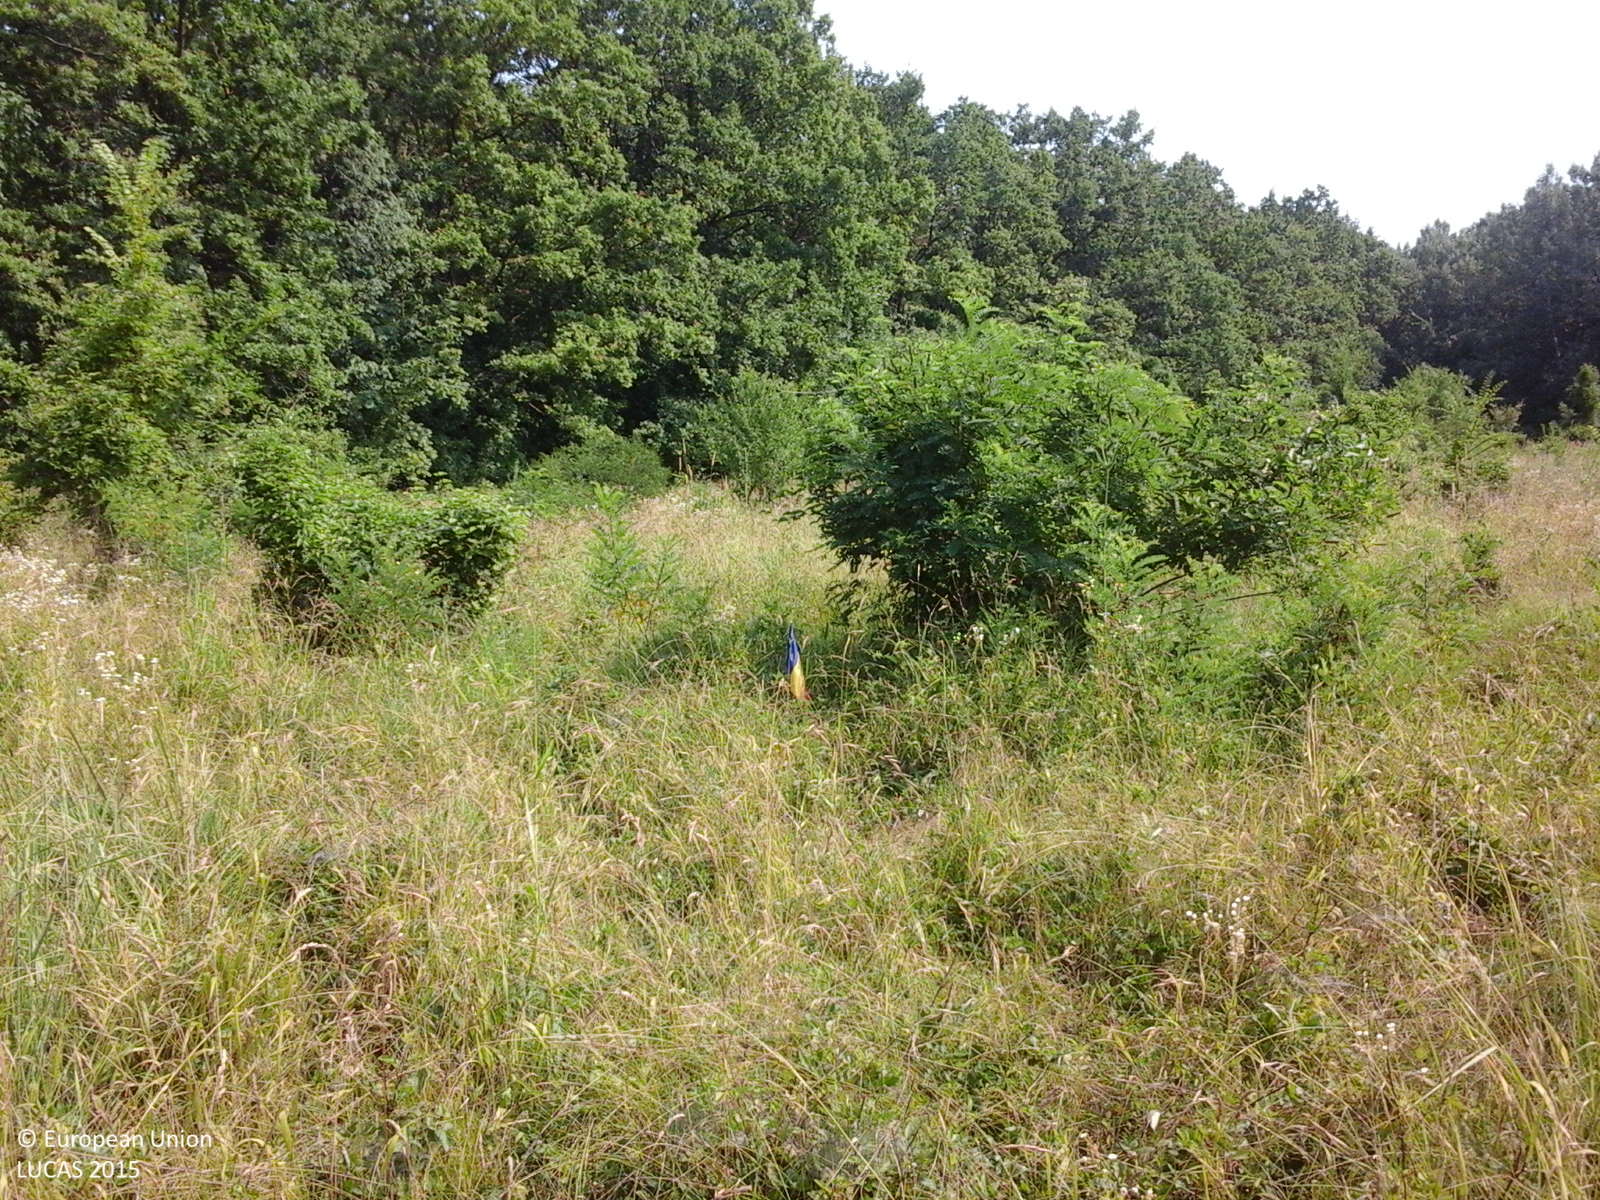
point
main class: Grassland
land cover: Grassland with sparse tree/shrub cover
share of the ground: > 75 %
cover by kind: herbaceous plants 85 %, shrubs 10 %, broadleaved forest trees 5 %
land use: Forestry
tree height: < 5 m
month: July
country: RO
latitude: 44.7913
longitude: 26.3316
